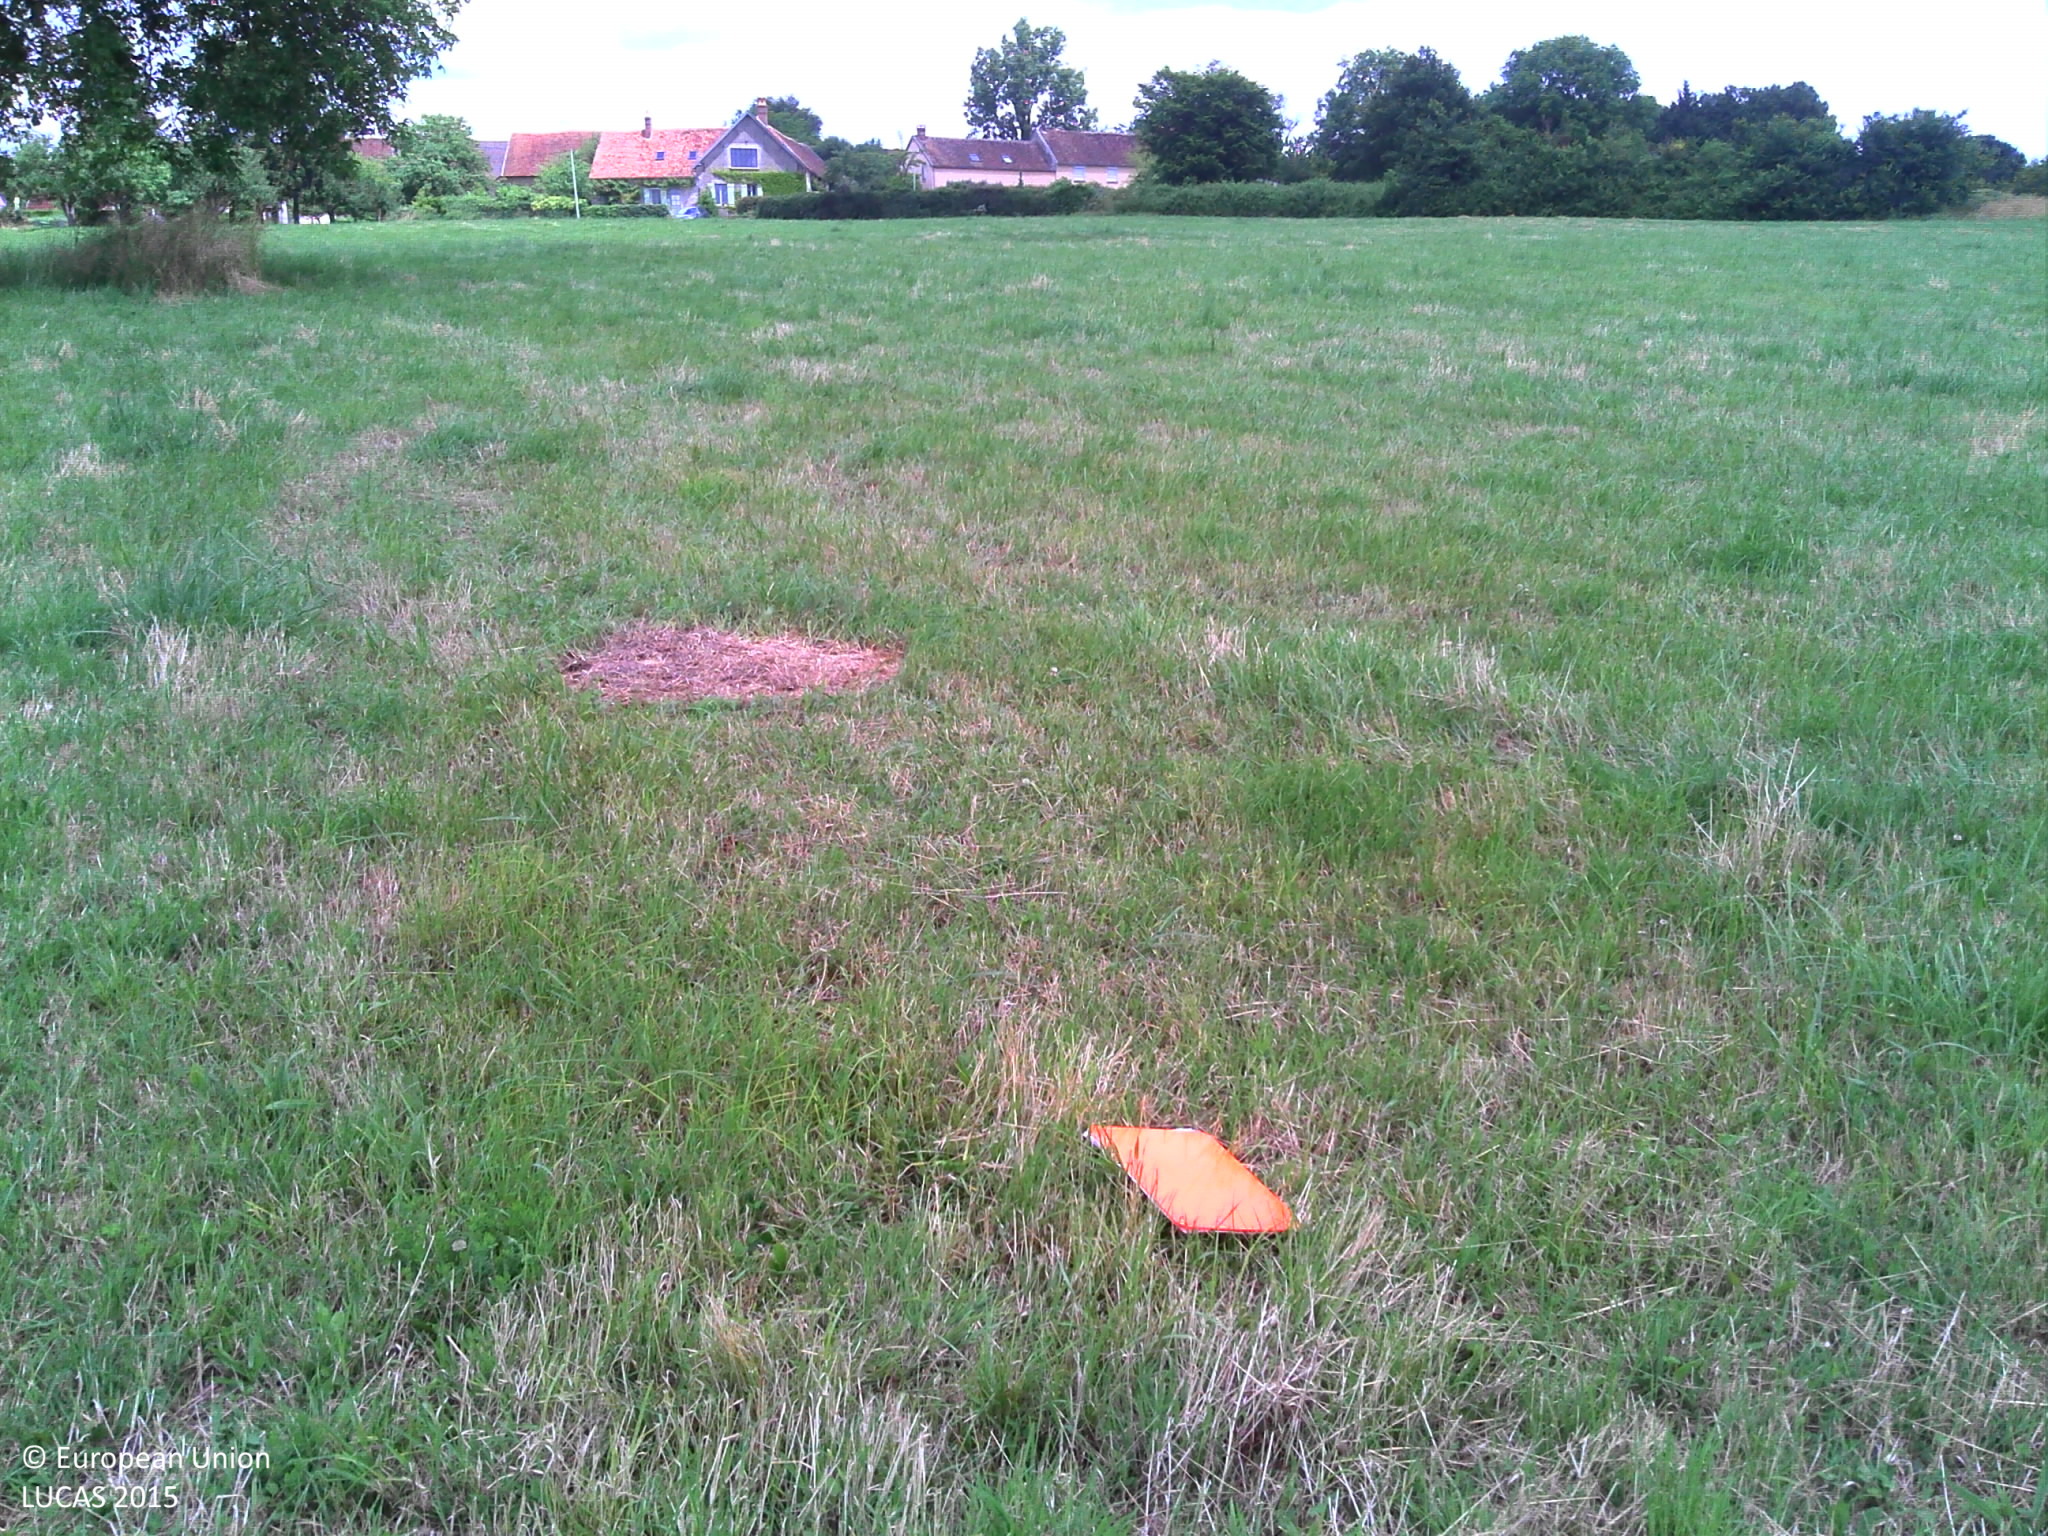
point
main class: Grassland
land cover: Grassland without tree/shrub cover
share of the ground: > 75 %
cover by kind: herbaceous plants 100 %
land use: Agriculture (excluding fallow land and kitchen gardens)
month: June
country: FR
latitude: 47.5035
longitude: 3.1311
